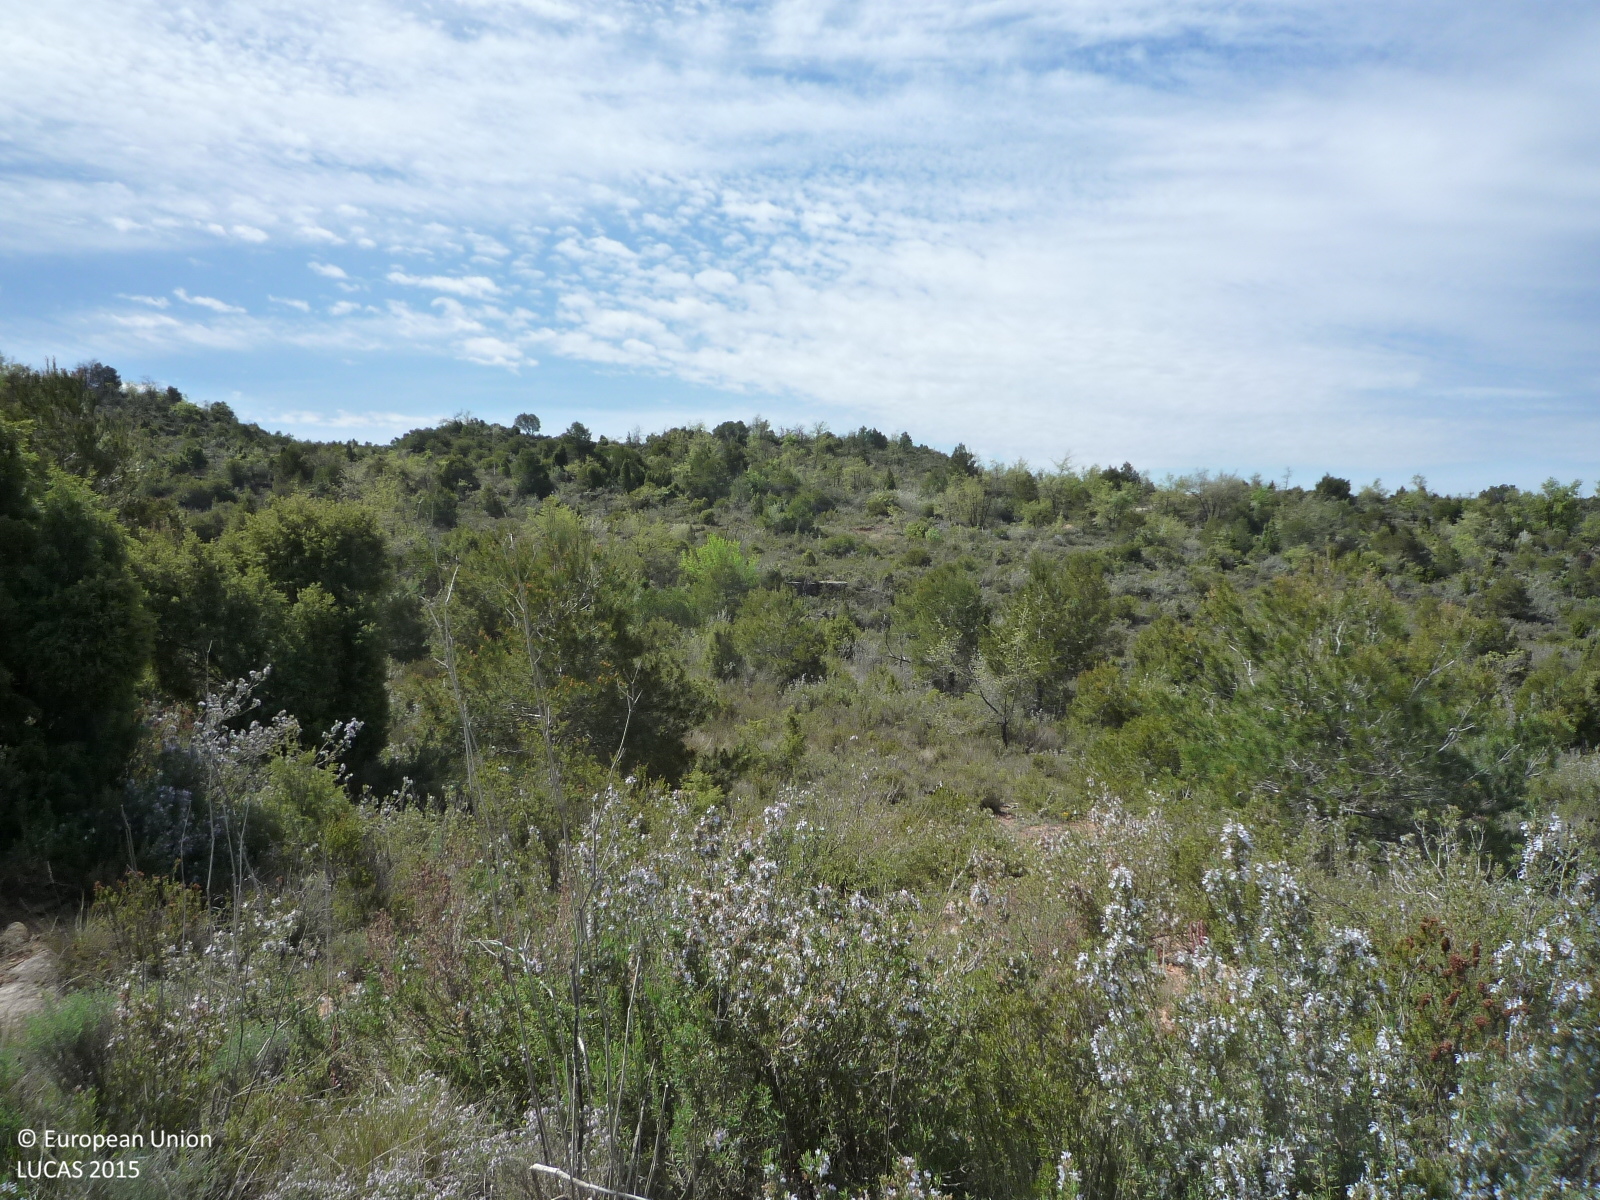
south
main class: Shrubland
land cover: Shrubland with sparse tree cover
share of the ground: > 75 %
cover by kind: shrubs 60 %, herbaceous plants 35 %, broadleaved forest trees 5 %
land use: Semi-natural and natural areas not in use
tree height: < 5 m
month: April
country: ES
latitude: 41.7107
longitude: 1.6620
